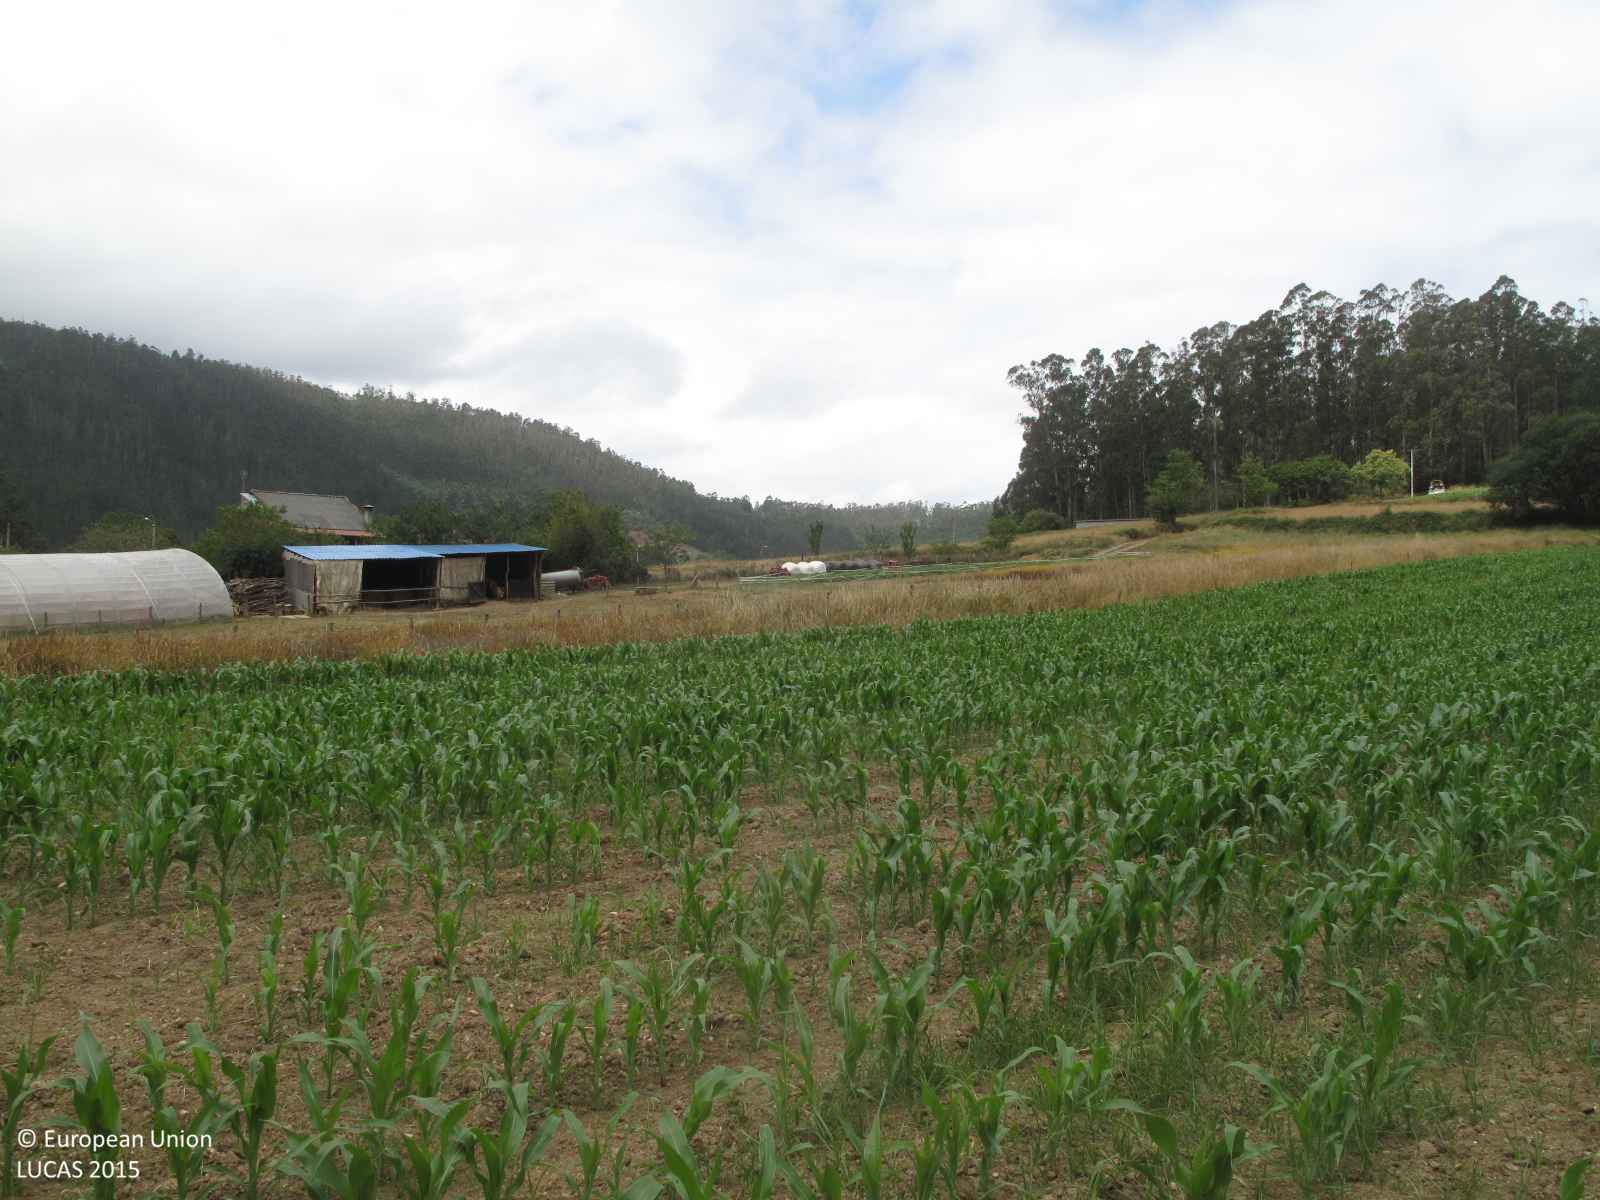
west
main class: Cropland
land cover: Maize
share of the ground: 25 - 50 %
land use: Agriculture (excluding fallow land and kitchen gardens)
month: July
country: ES
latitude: 43.4957
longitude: -8.1177
